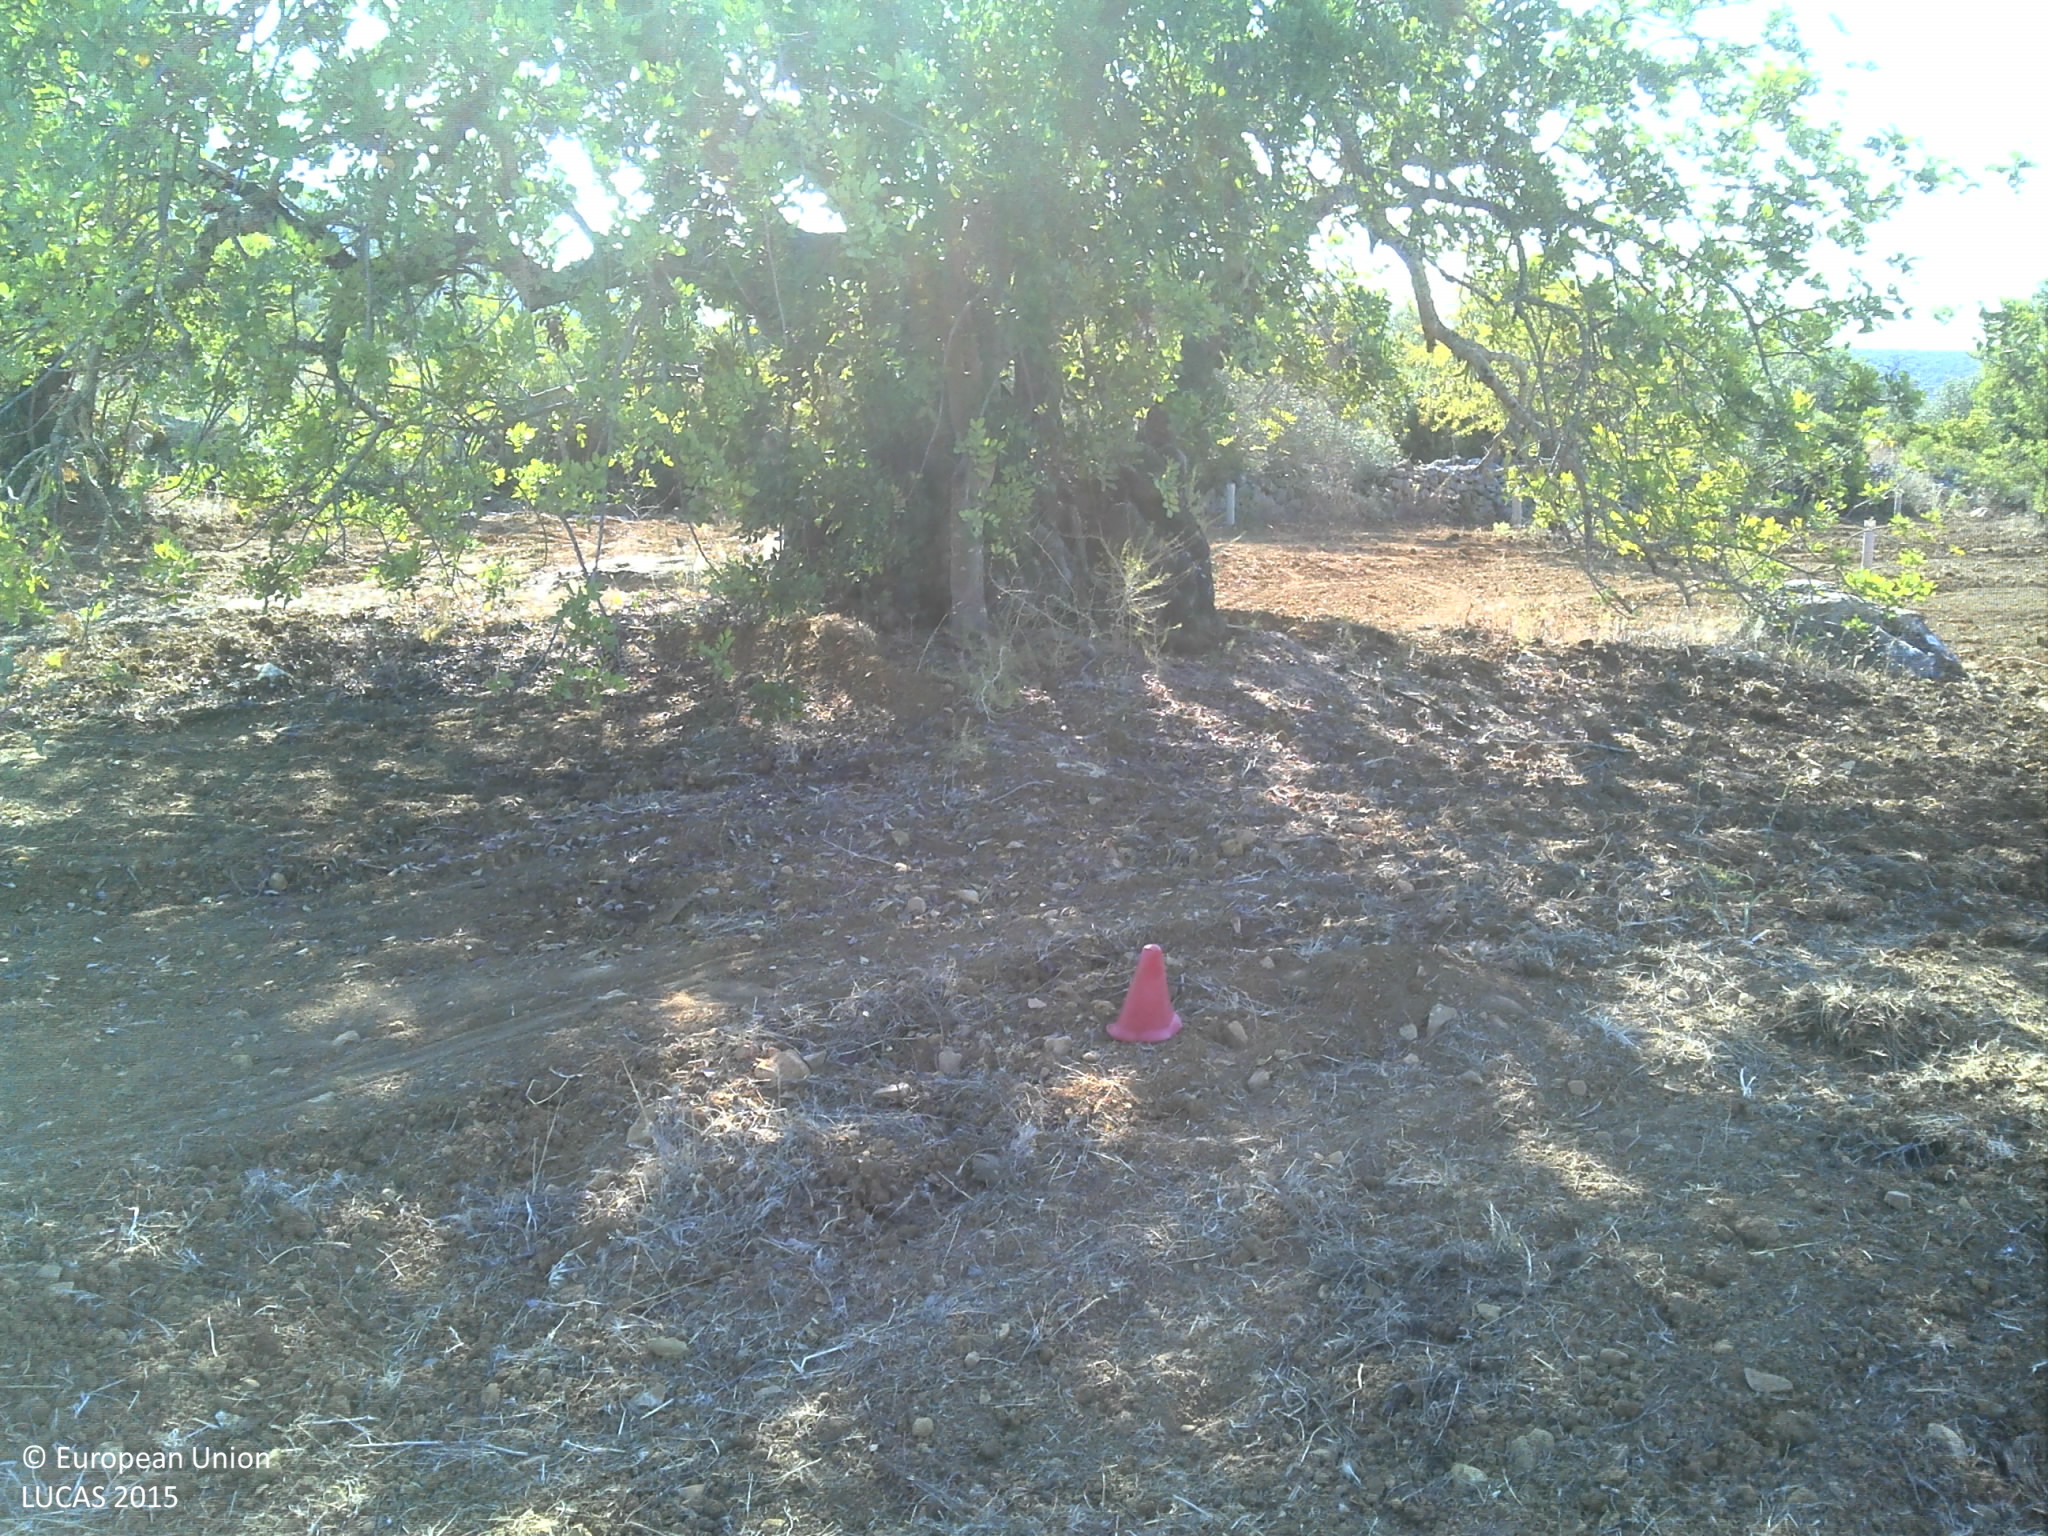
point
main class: Cropland
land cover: Permanent industrial crops
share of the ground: 10 - 25 %
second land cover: Other bare soil
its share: > 75 %
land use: Agriculture (excluding fallow land and kitchen gardens)
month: June
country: PT
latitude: 37.1088
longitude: -7.7987
